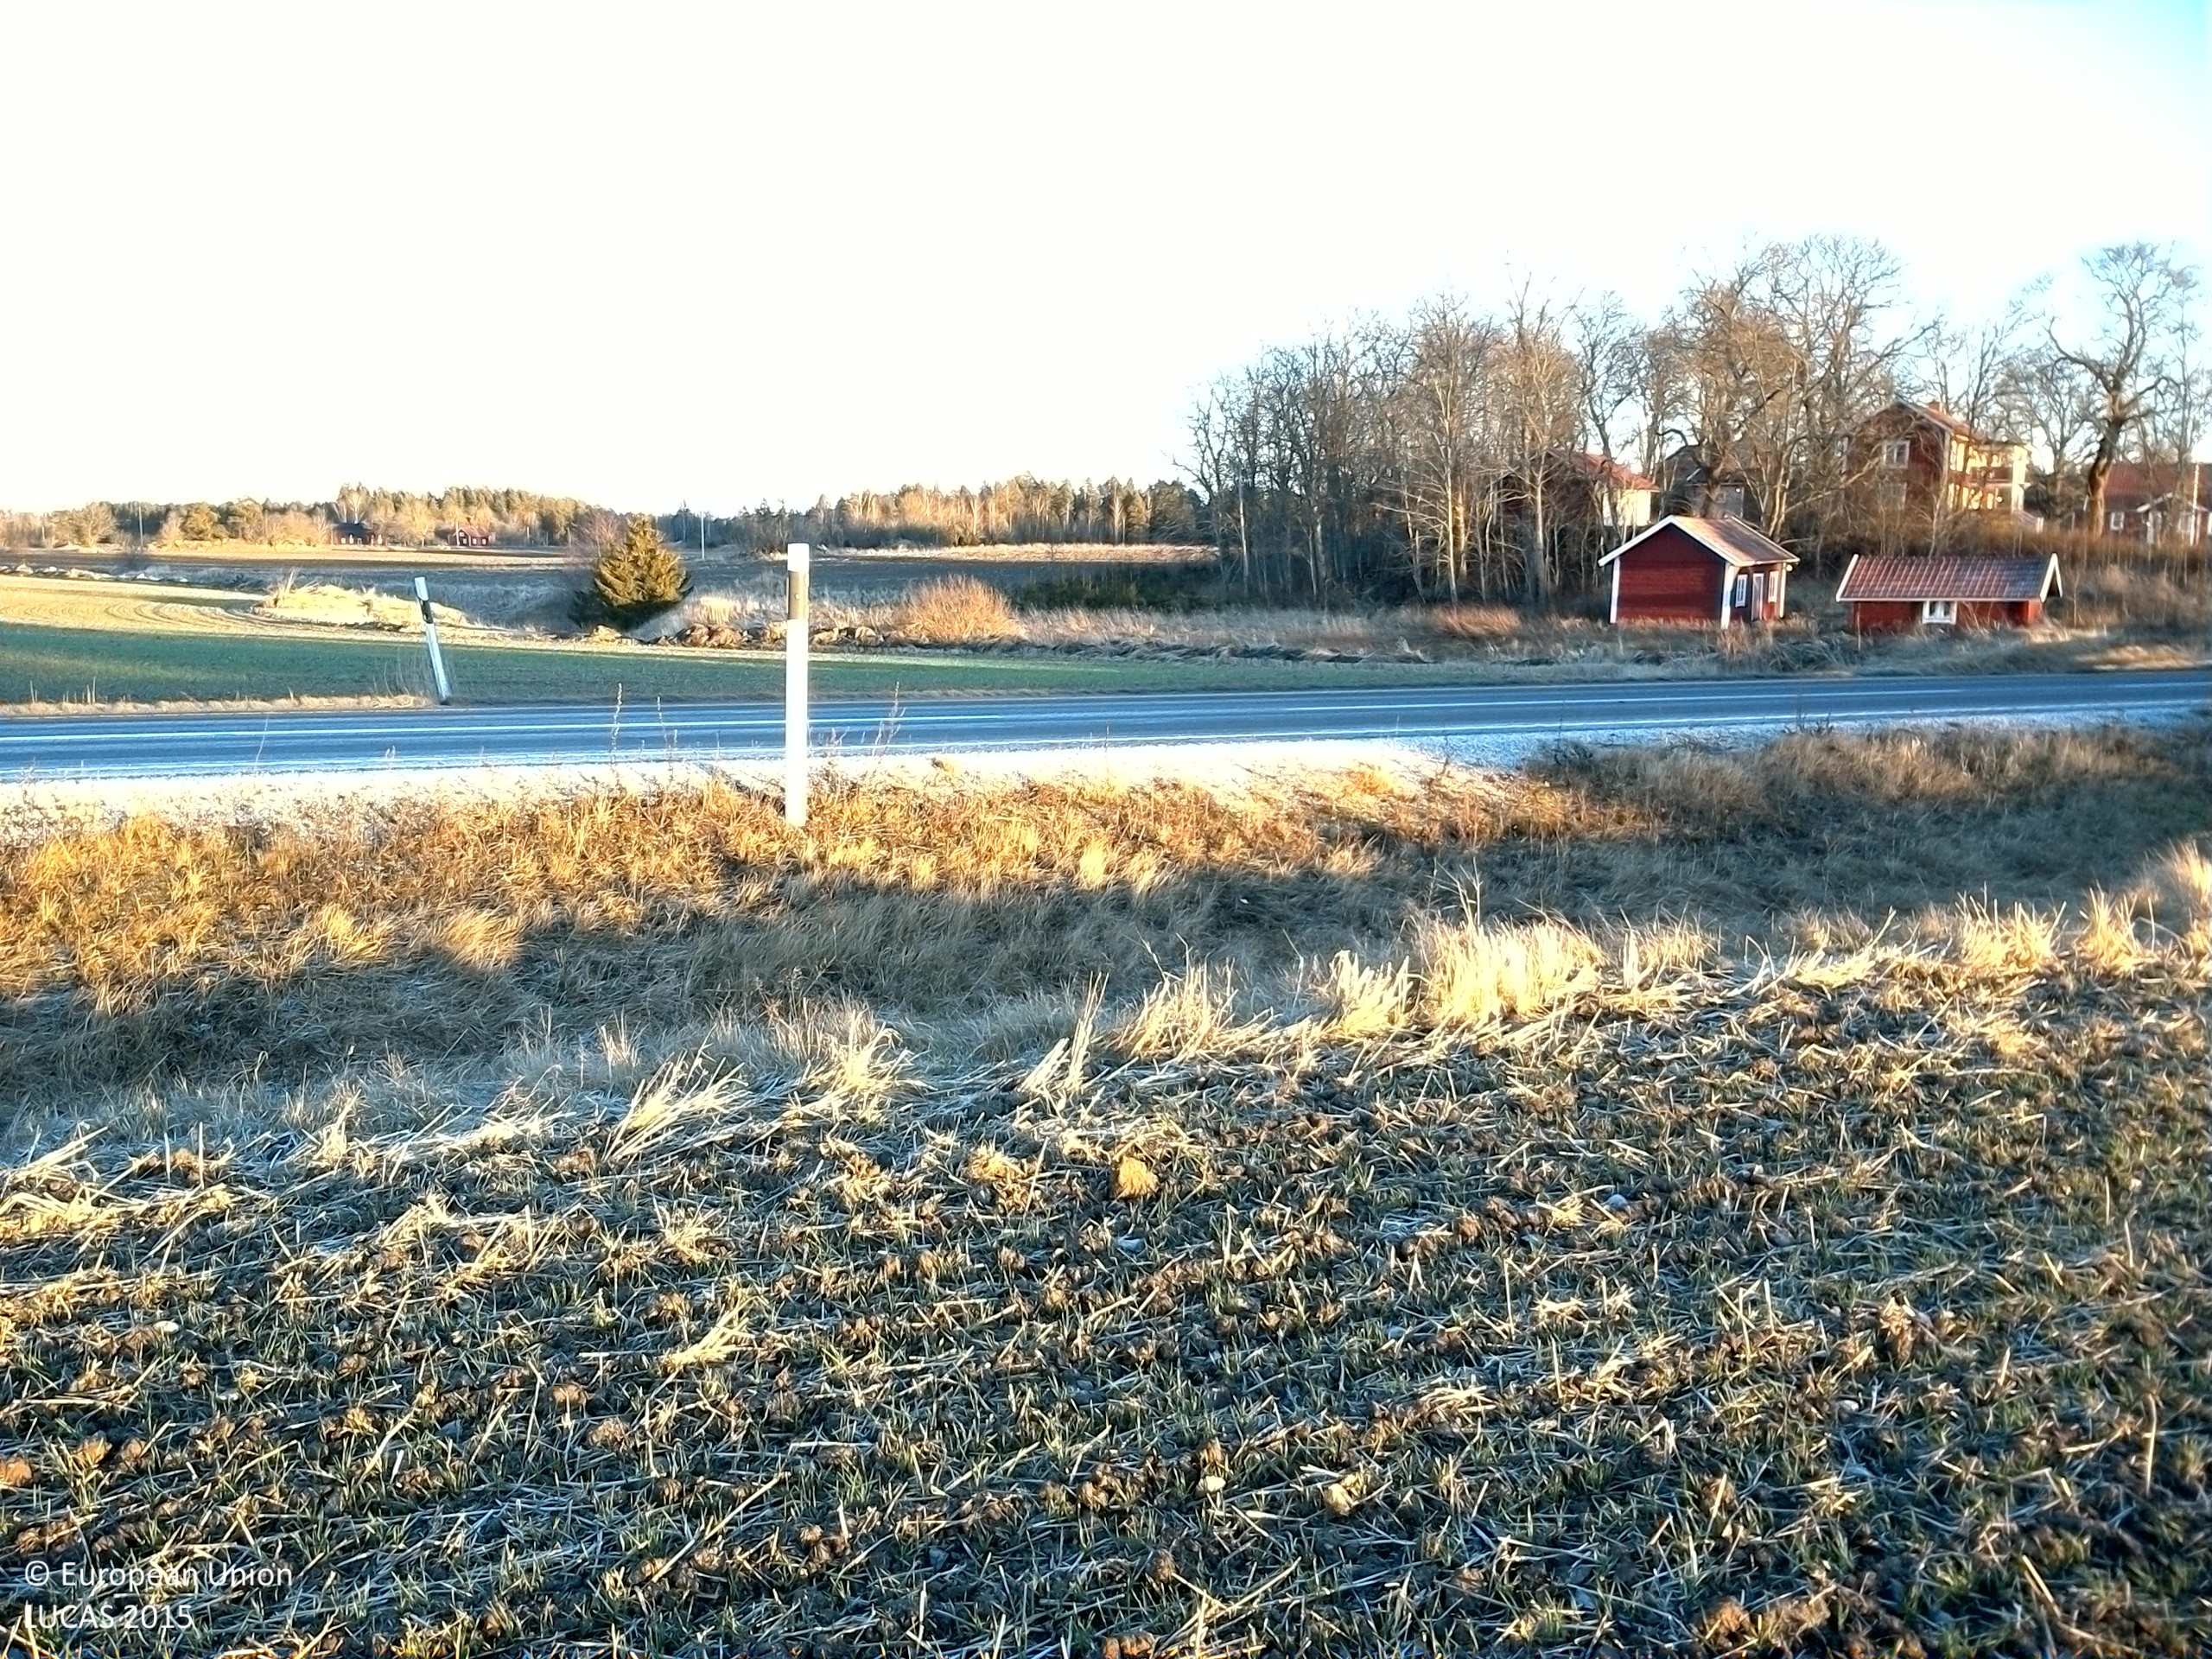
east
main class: Cropland
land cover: Common wheat
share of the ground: > 75 %
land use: Agriculture (excluding fallow land and kitchen gardens)
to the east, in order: Common wheat; Grass margins; Ditches and canals; Grass margins; Paved roads, cycling and walking lanes; Grassland without tree/shrub cover; Ditches and canals; Grass margins; Common wheat; Grassland without tree/shrub cover; Rivers and streams; Grassland with sparse tree/shrub cover; Spruce dominated coniferous woodland; Broadleaved woodland; Spruce dominated coniferous woodland; Spruce dominated mixed woodland; Grassland with sparse tree/shrub cover; Ditches and canals; Grass margins; Other bare soil
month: December
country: SE
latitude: 59.2882
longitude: 16.5412
